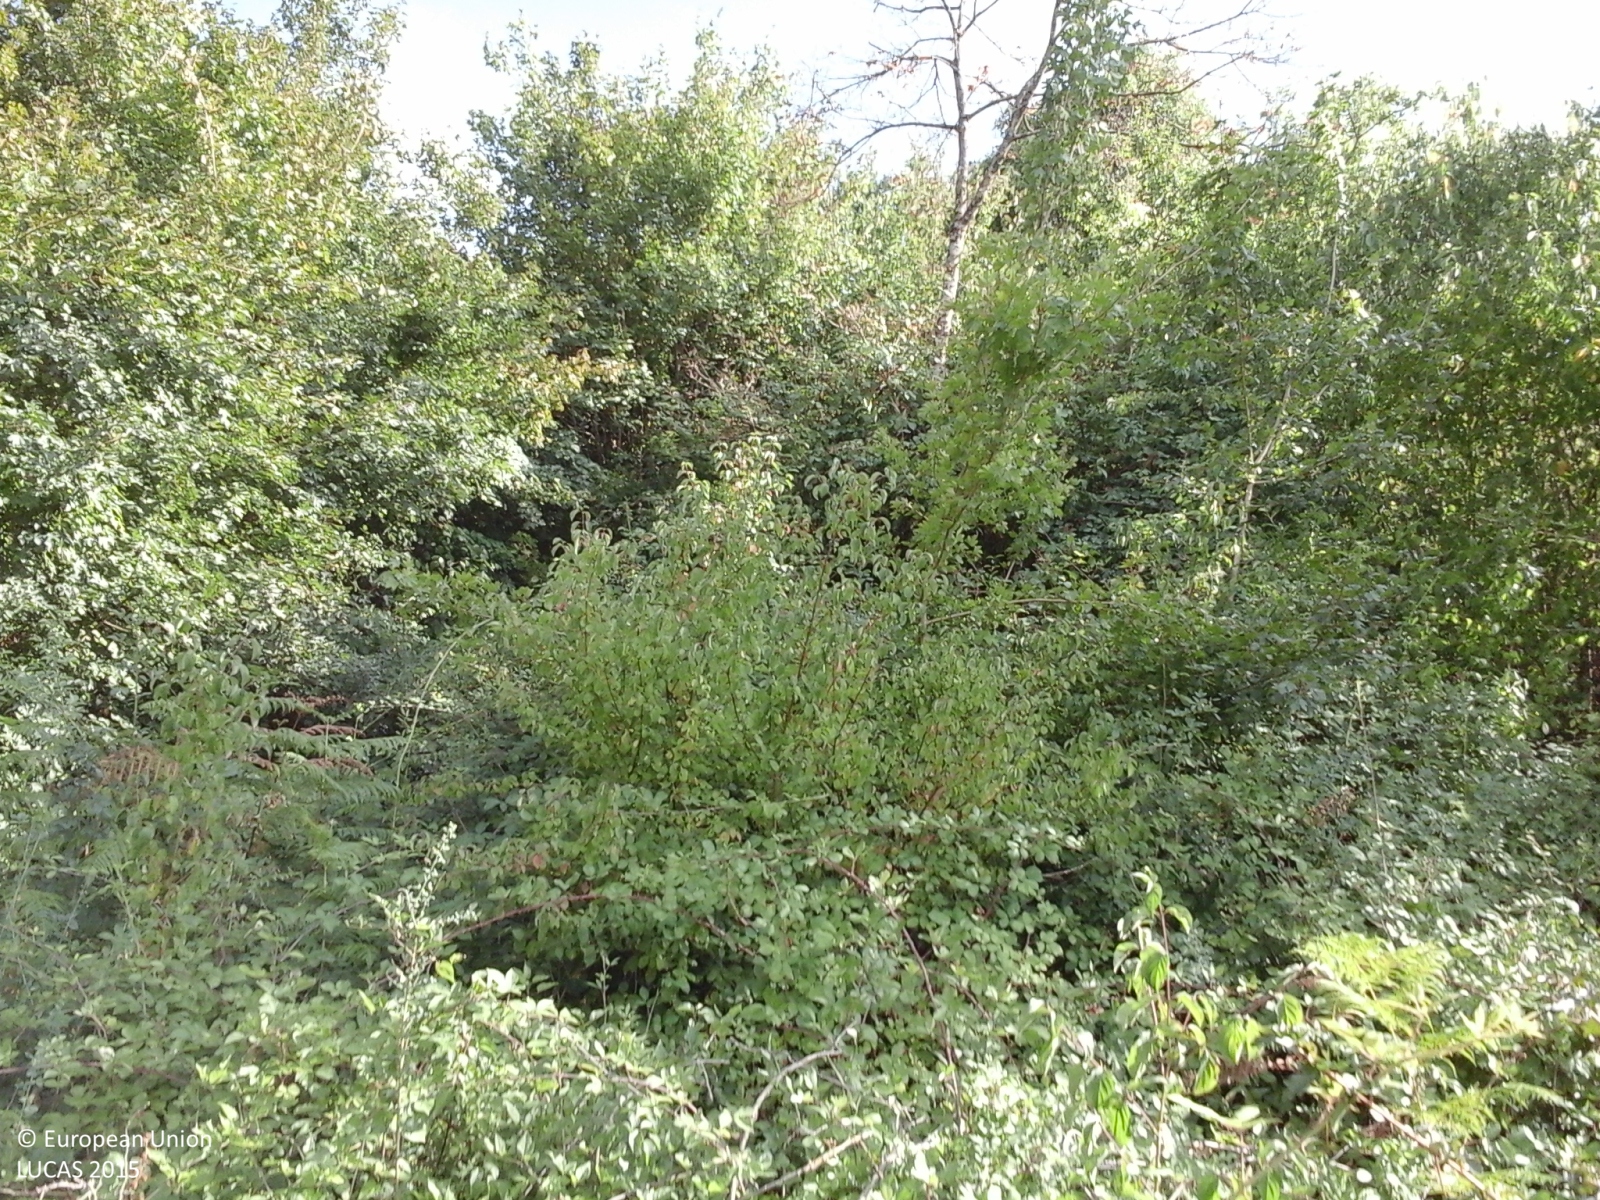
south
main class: Woodland
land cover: Broadleaved woodland
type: thermophilous deciduous forest
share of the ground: > 75 %
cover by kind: broadleaved forest trees 85 %, shrubs 10 %, herbaceous plants 5 %
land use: Semi-natural and natural areas not in use
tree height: > 5 m
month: August
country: IT
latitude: 41.5681
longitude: 14.2897
